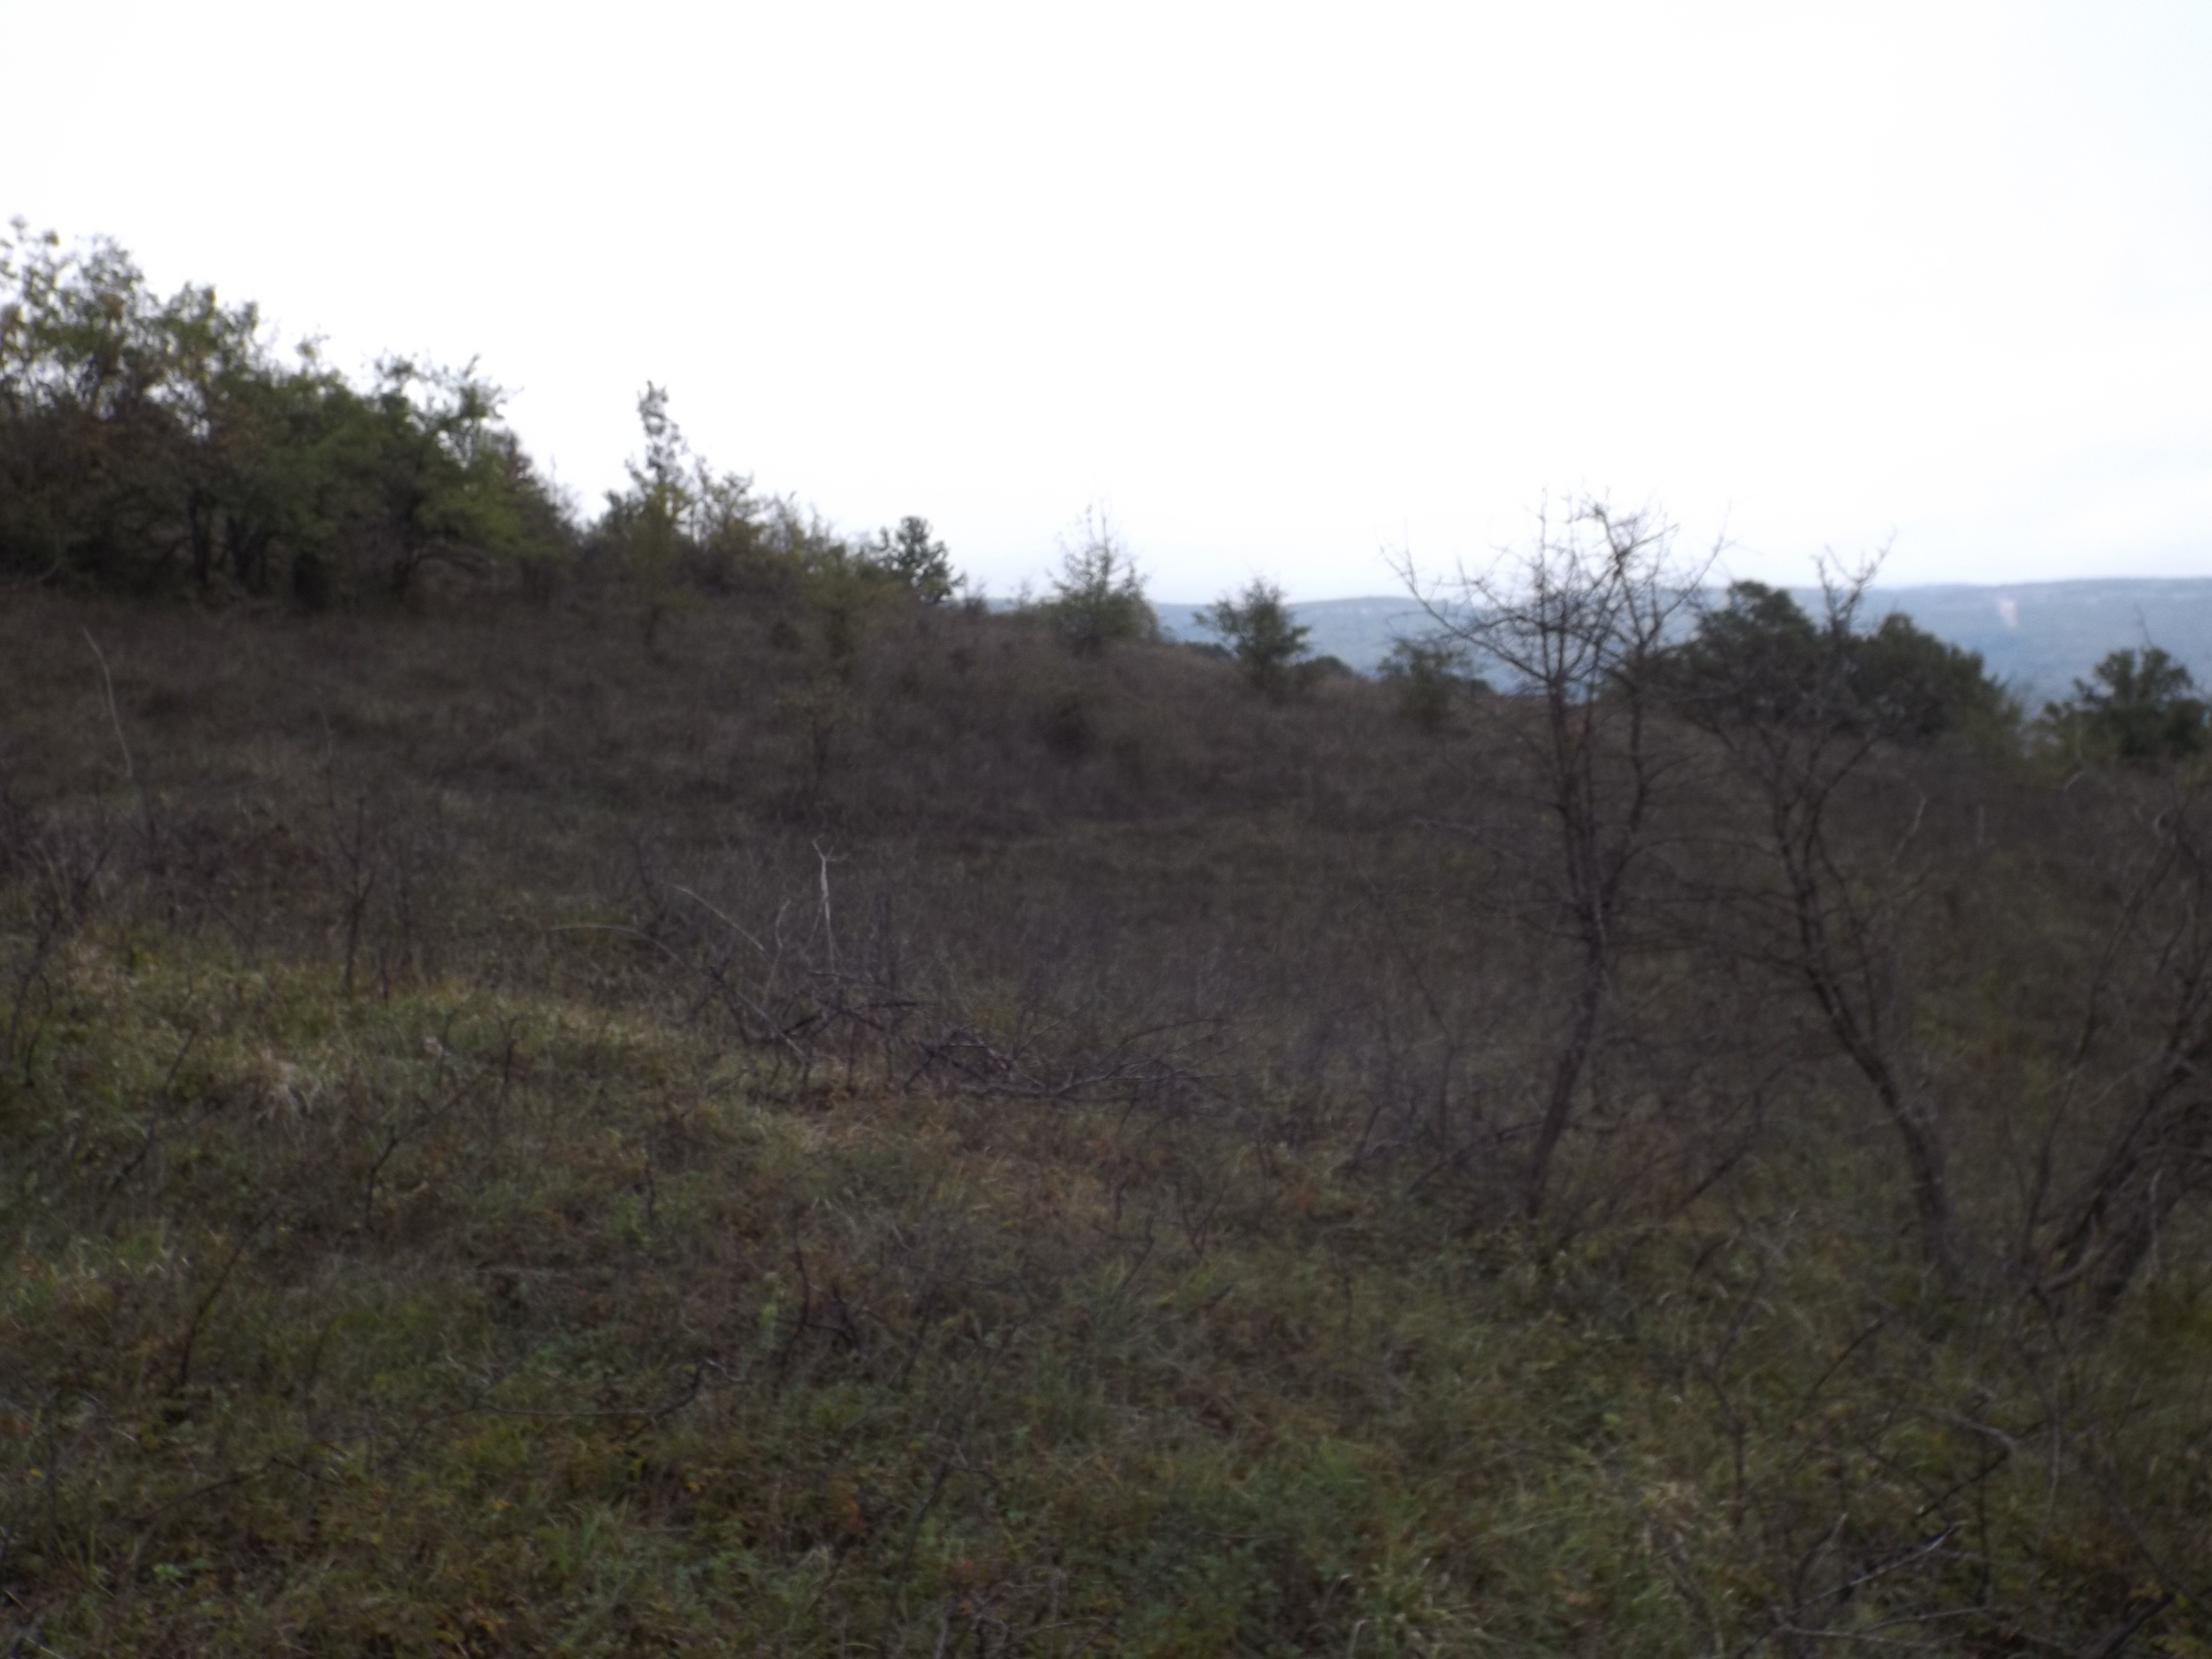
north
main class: Shrubland
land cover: Shrubland with sparse tree cover
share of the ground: 50 - 75 %
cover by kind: shrubs 55 %, herbaceous plants 40 %, broadleaved forest trees 5 %
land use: Semi-natural and natural areas not in use
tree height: > 5 m
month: October
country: BG
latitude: 43.0320
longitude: 27.1884
